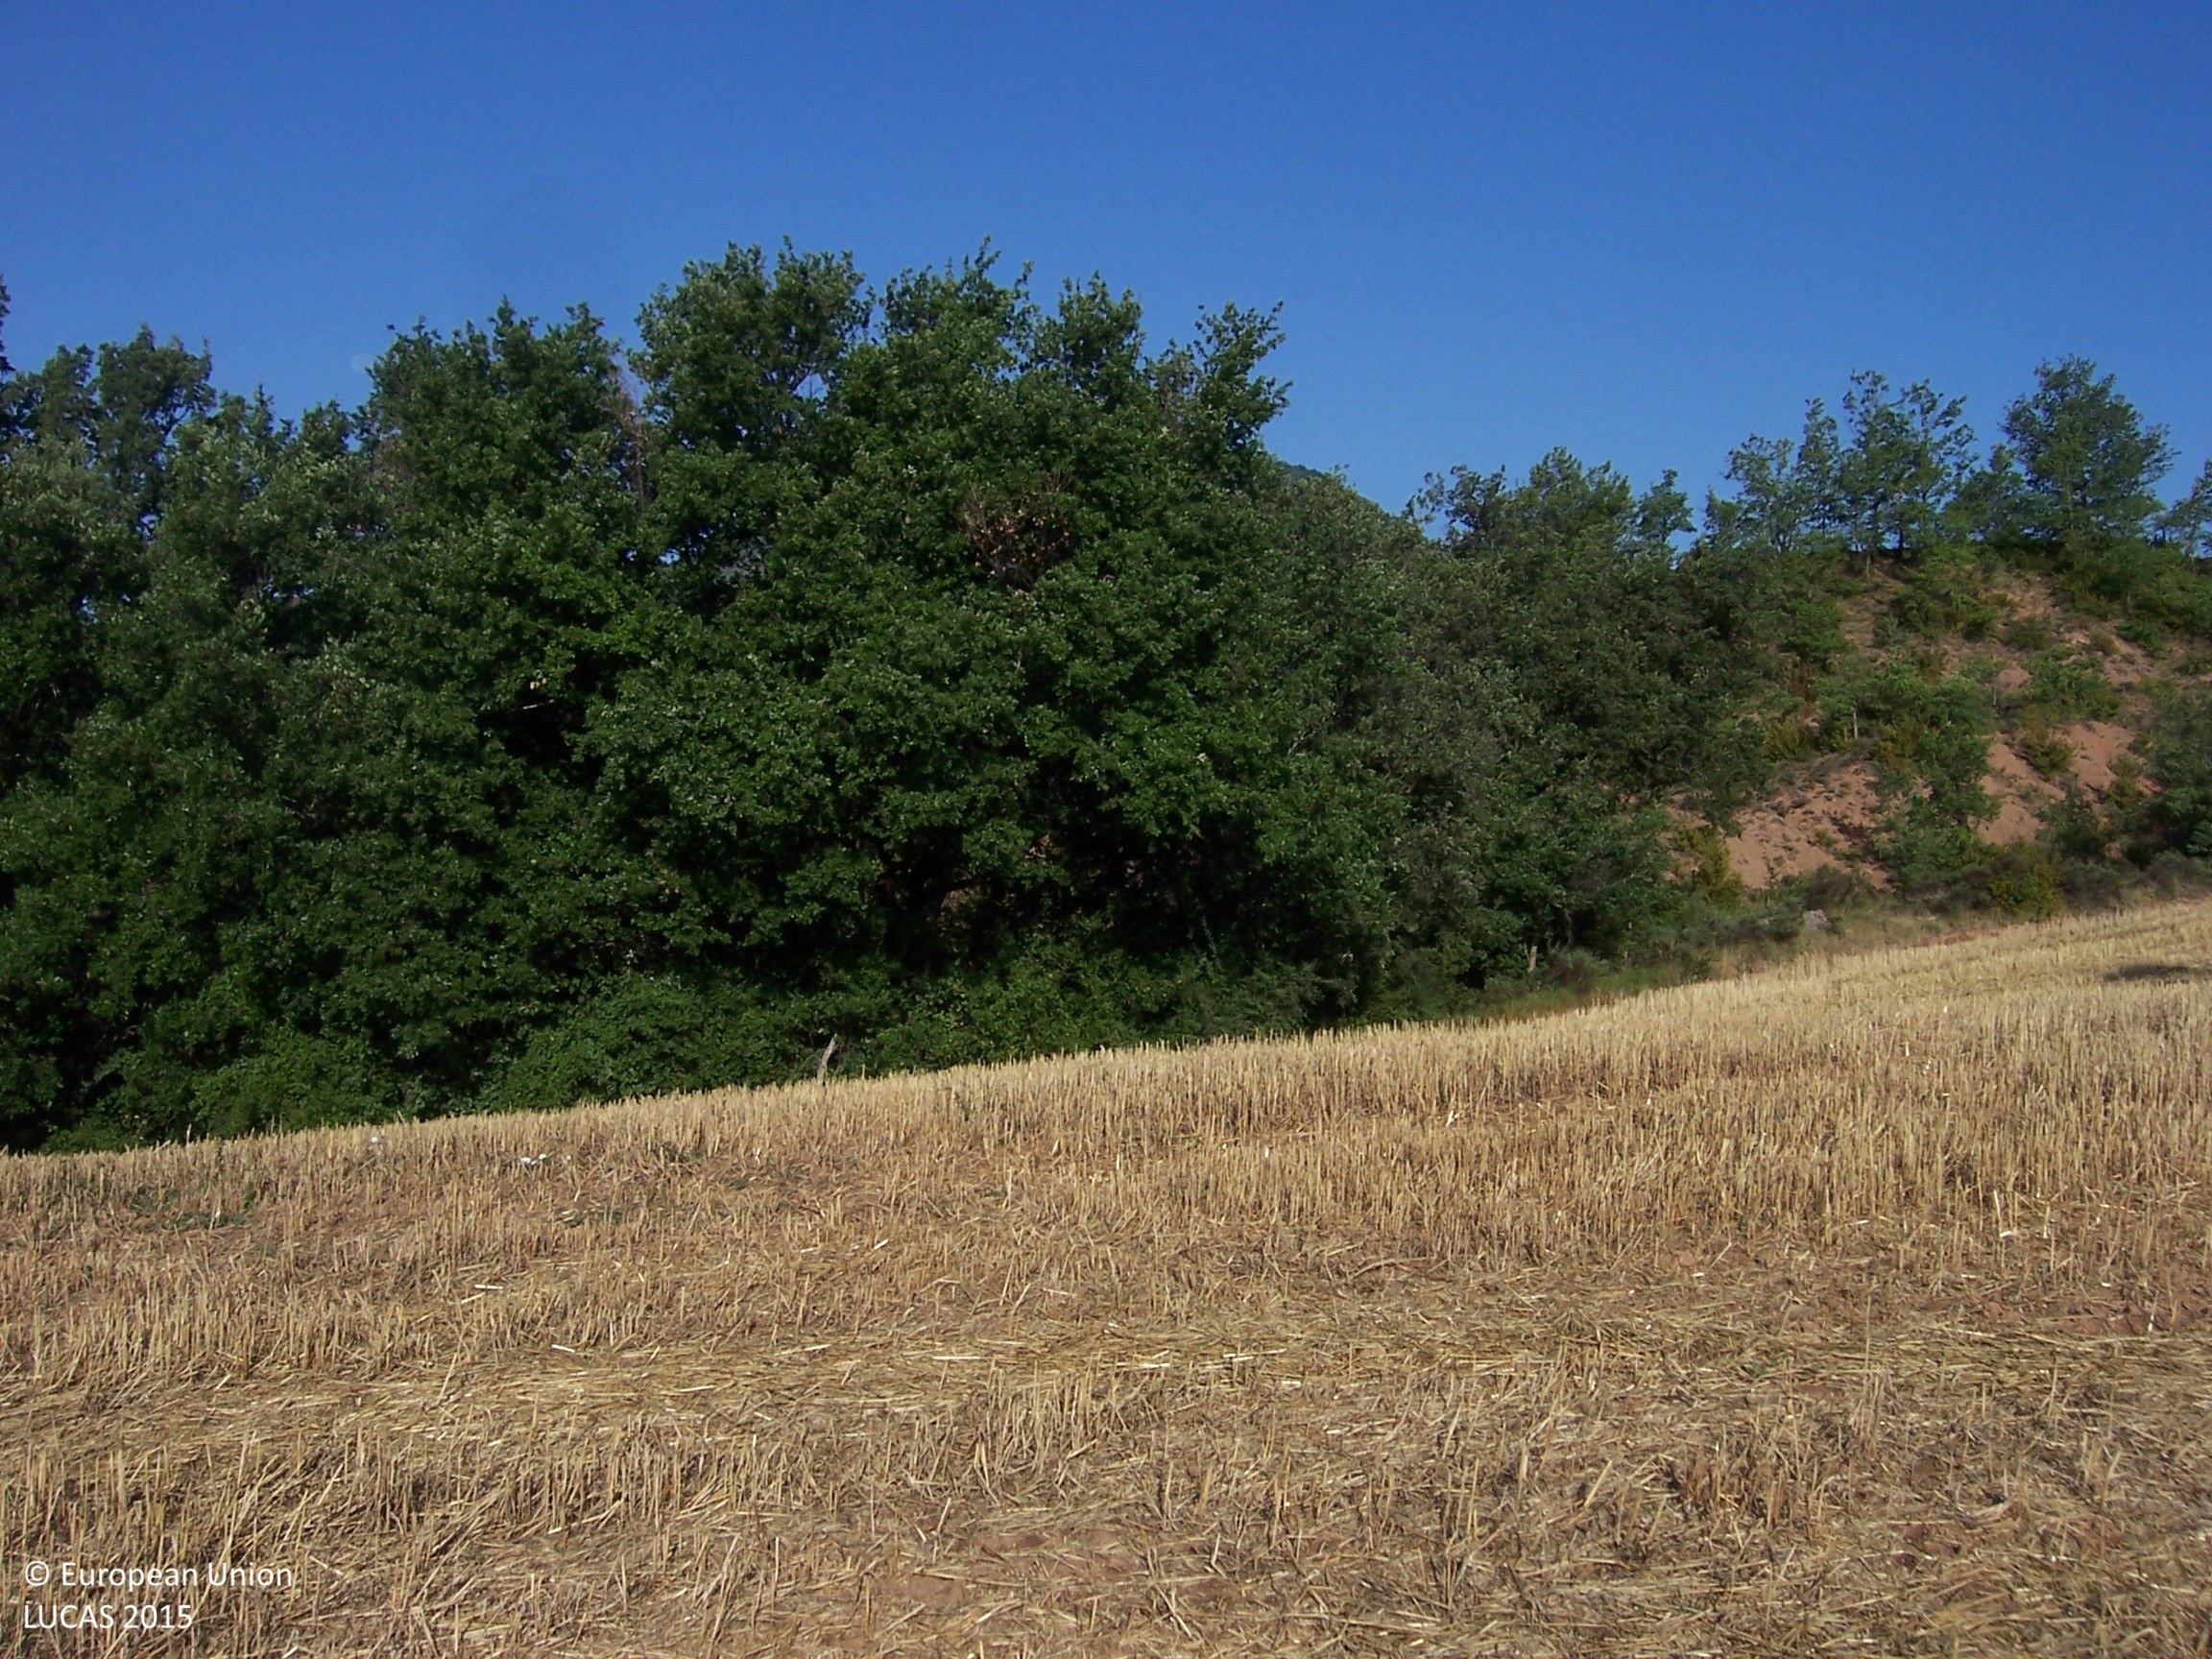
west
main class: Cropland
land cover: Common wheat
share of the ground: < 10 %
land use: Agriculture (excluding fallow land and kitchen gardens)
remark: Harvested field
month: August
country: ES
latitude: 42.5116
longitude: -0.4563
